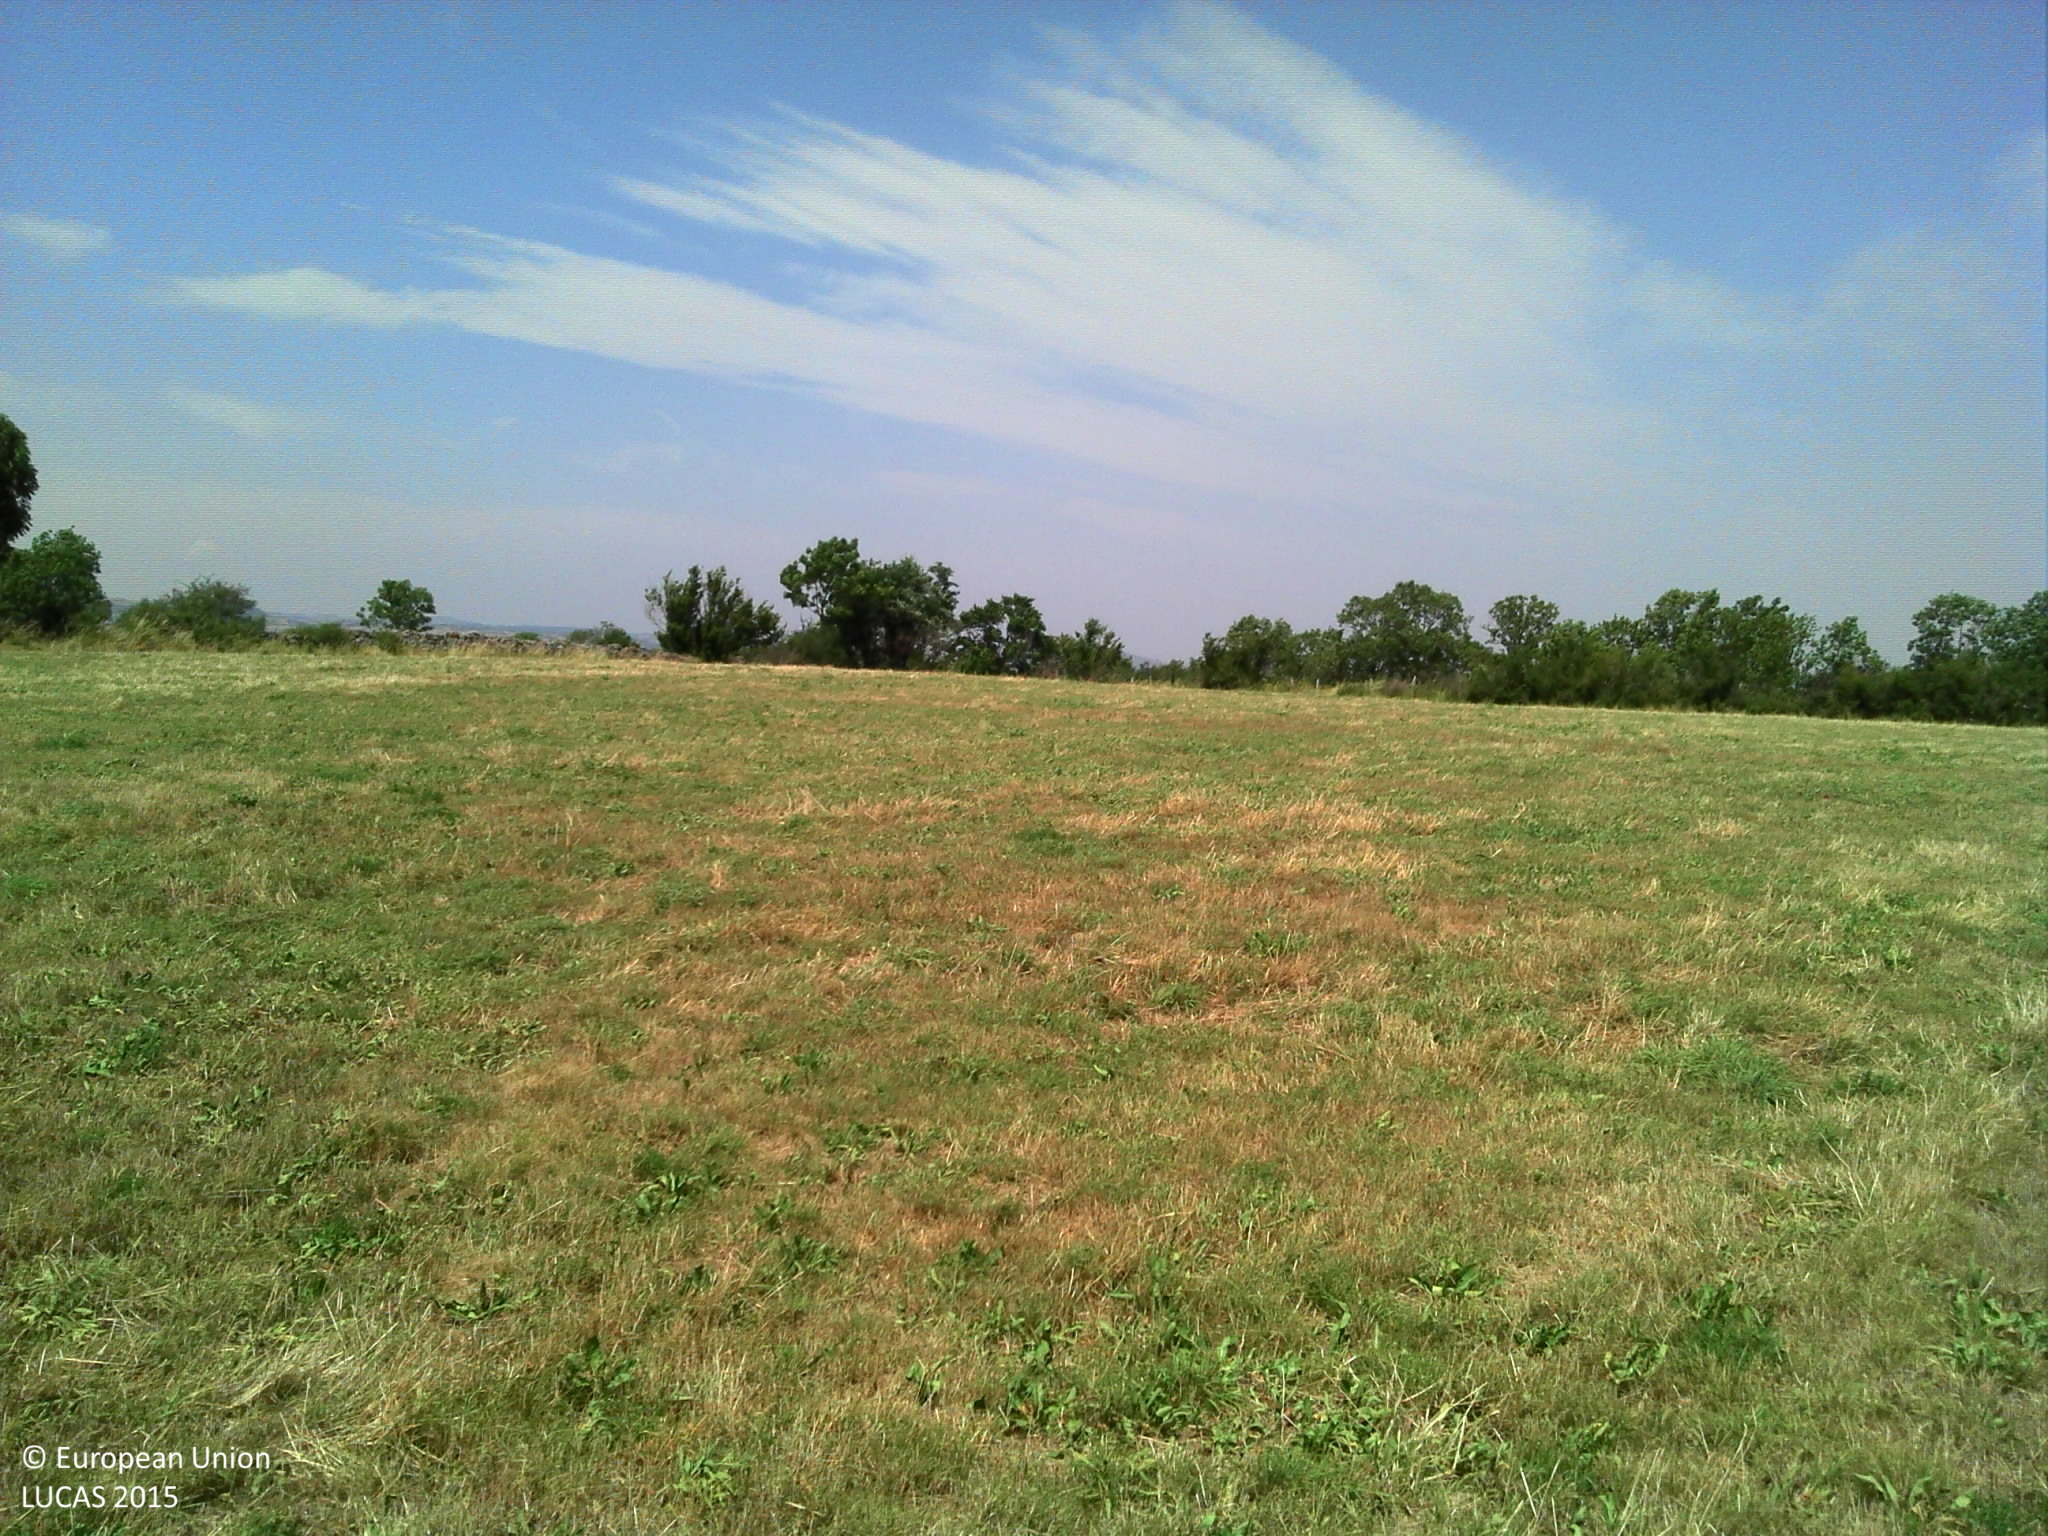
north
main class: Grassland
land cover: Grassland without tree/shrub cover
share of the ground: > 75 %
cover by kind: herbaceous plants 100 %
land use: Agriculture (excluding fallow land and kitchen gardens)
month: July
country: FR
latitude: 45.2071
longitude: 3.1138
